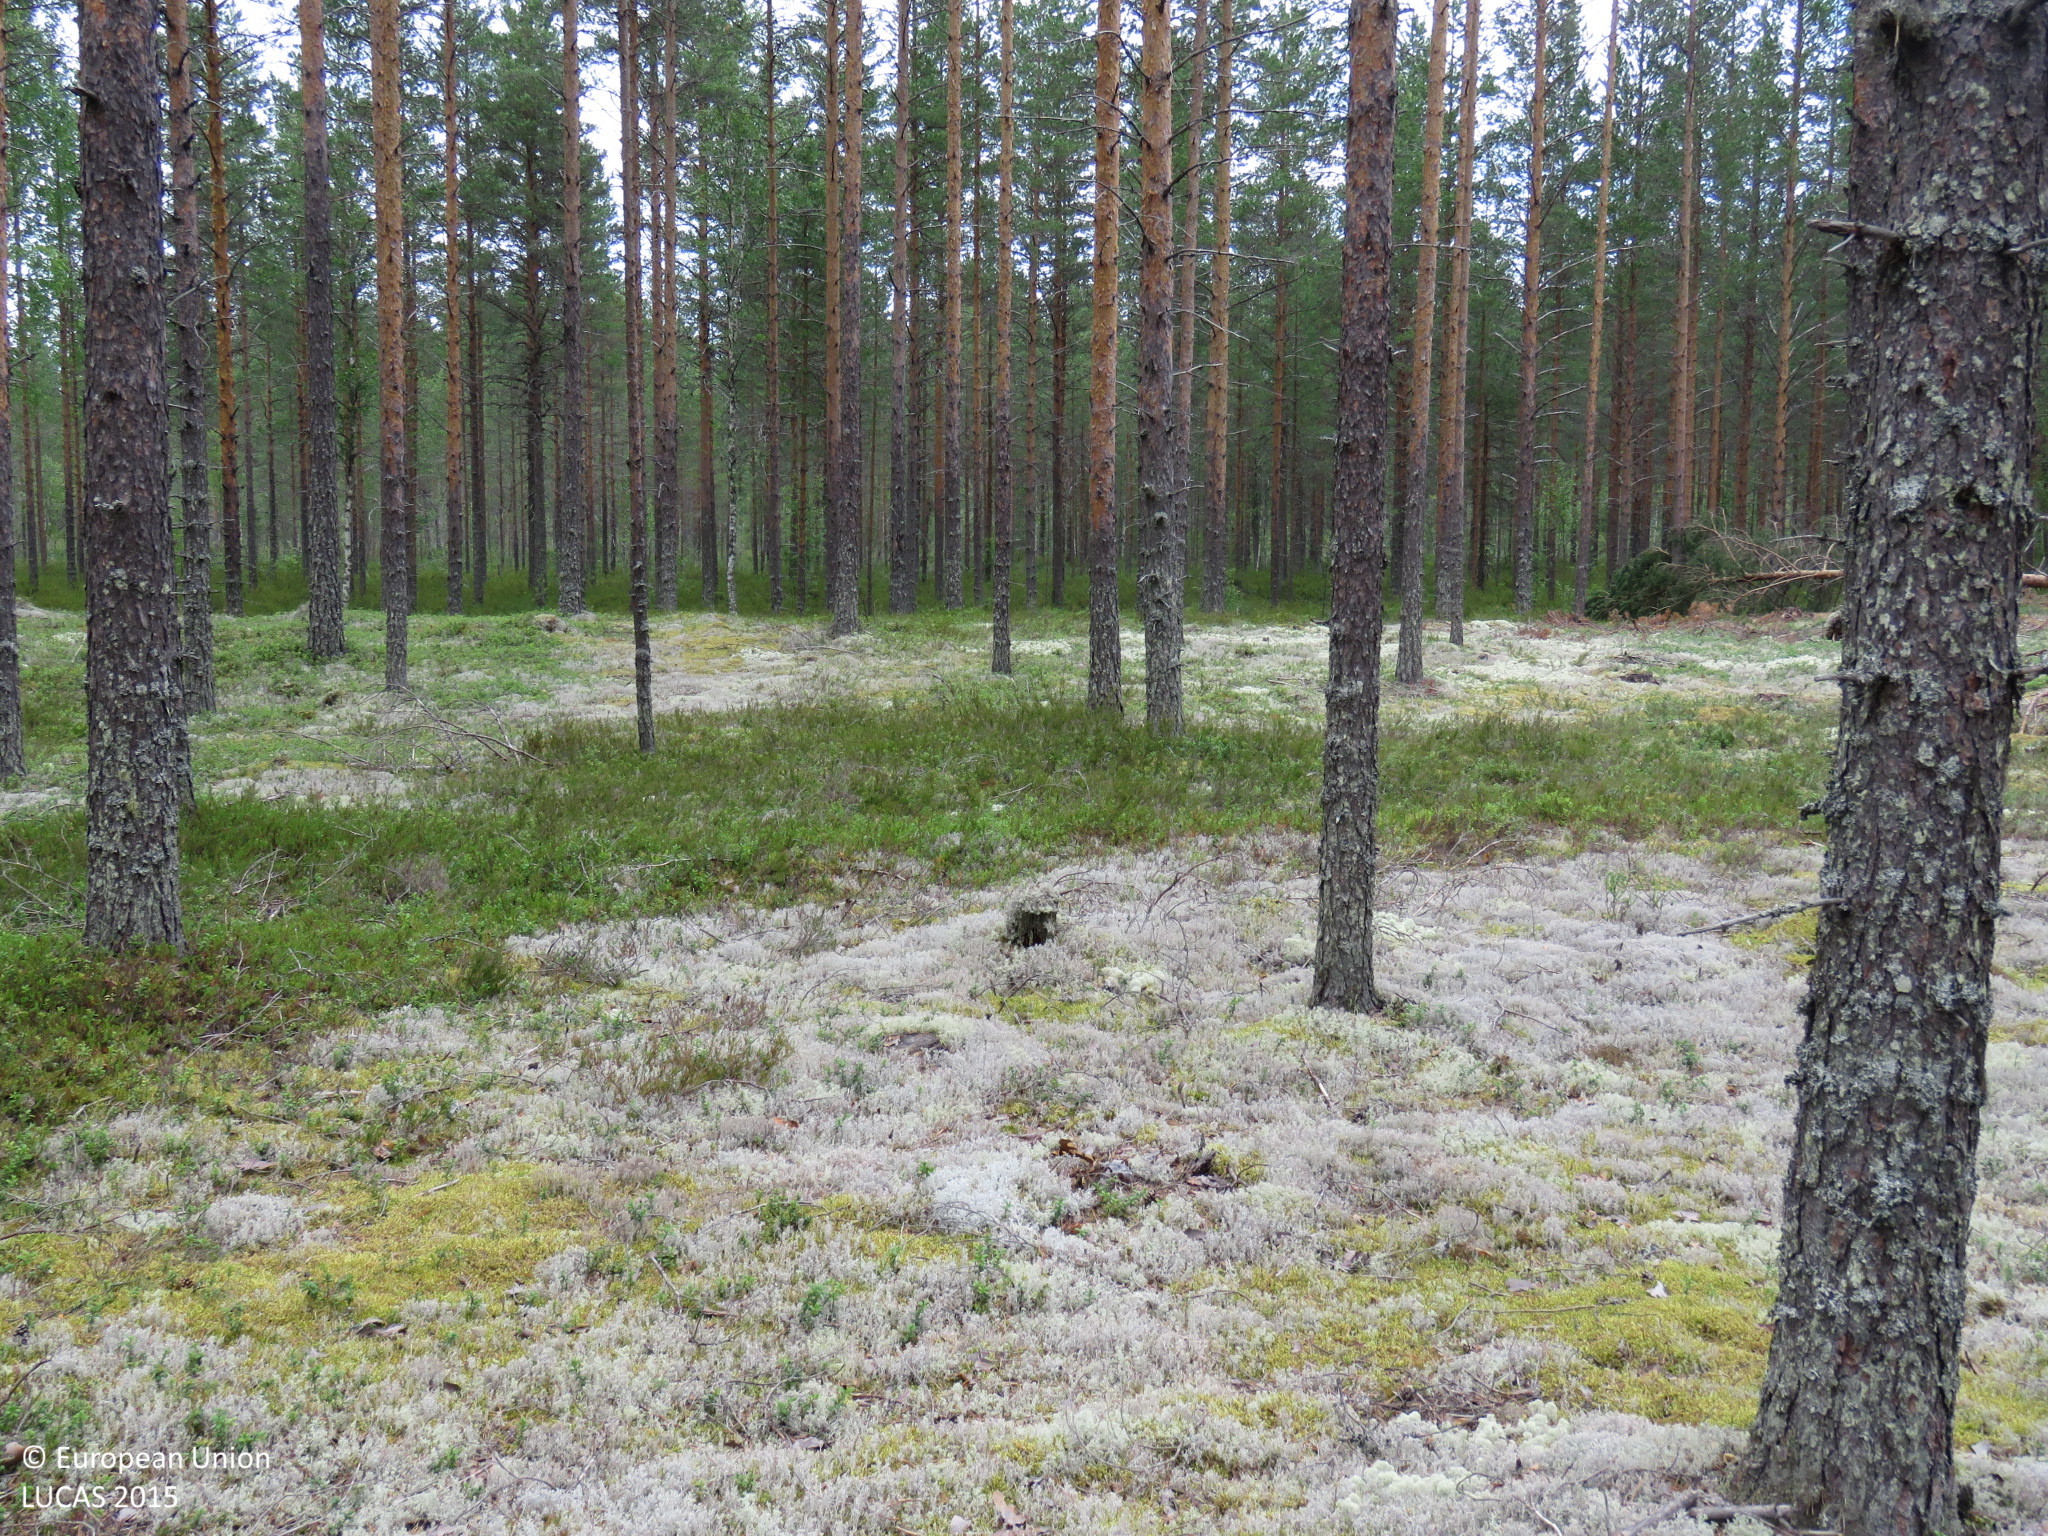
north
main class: Woodland
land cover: Pine dominated coniferous woodland
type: boreal forest
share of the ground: > 75 %
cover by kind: coniferous forest trees 75 %, lichens and mosses 15 %, shrubs 10 %
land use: Forestry
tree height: > 5 m
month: July
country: FI
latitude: 64.2591
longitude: 26.3975
